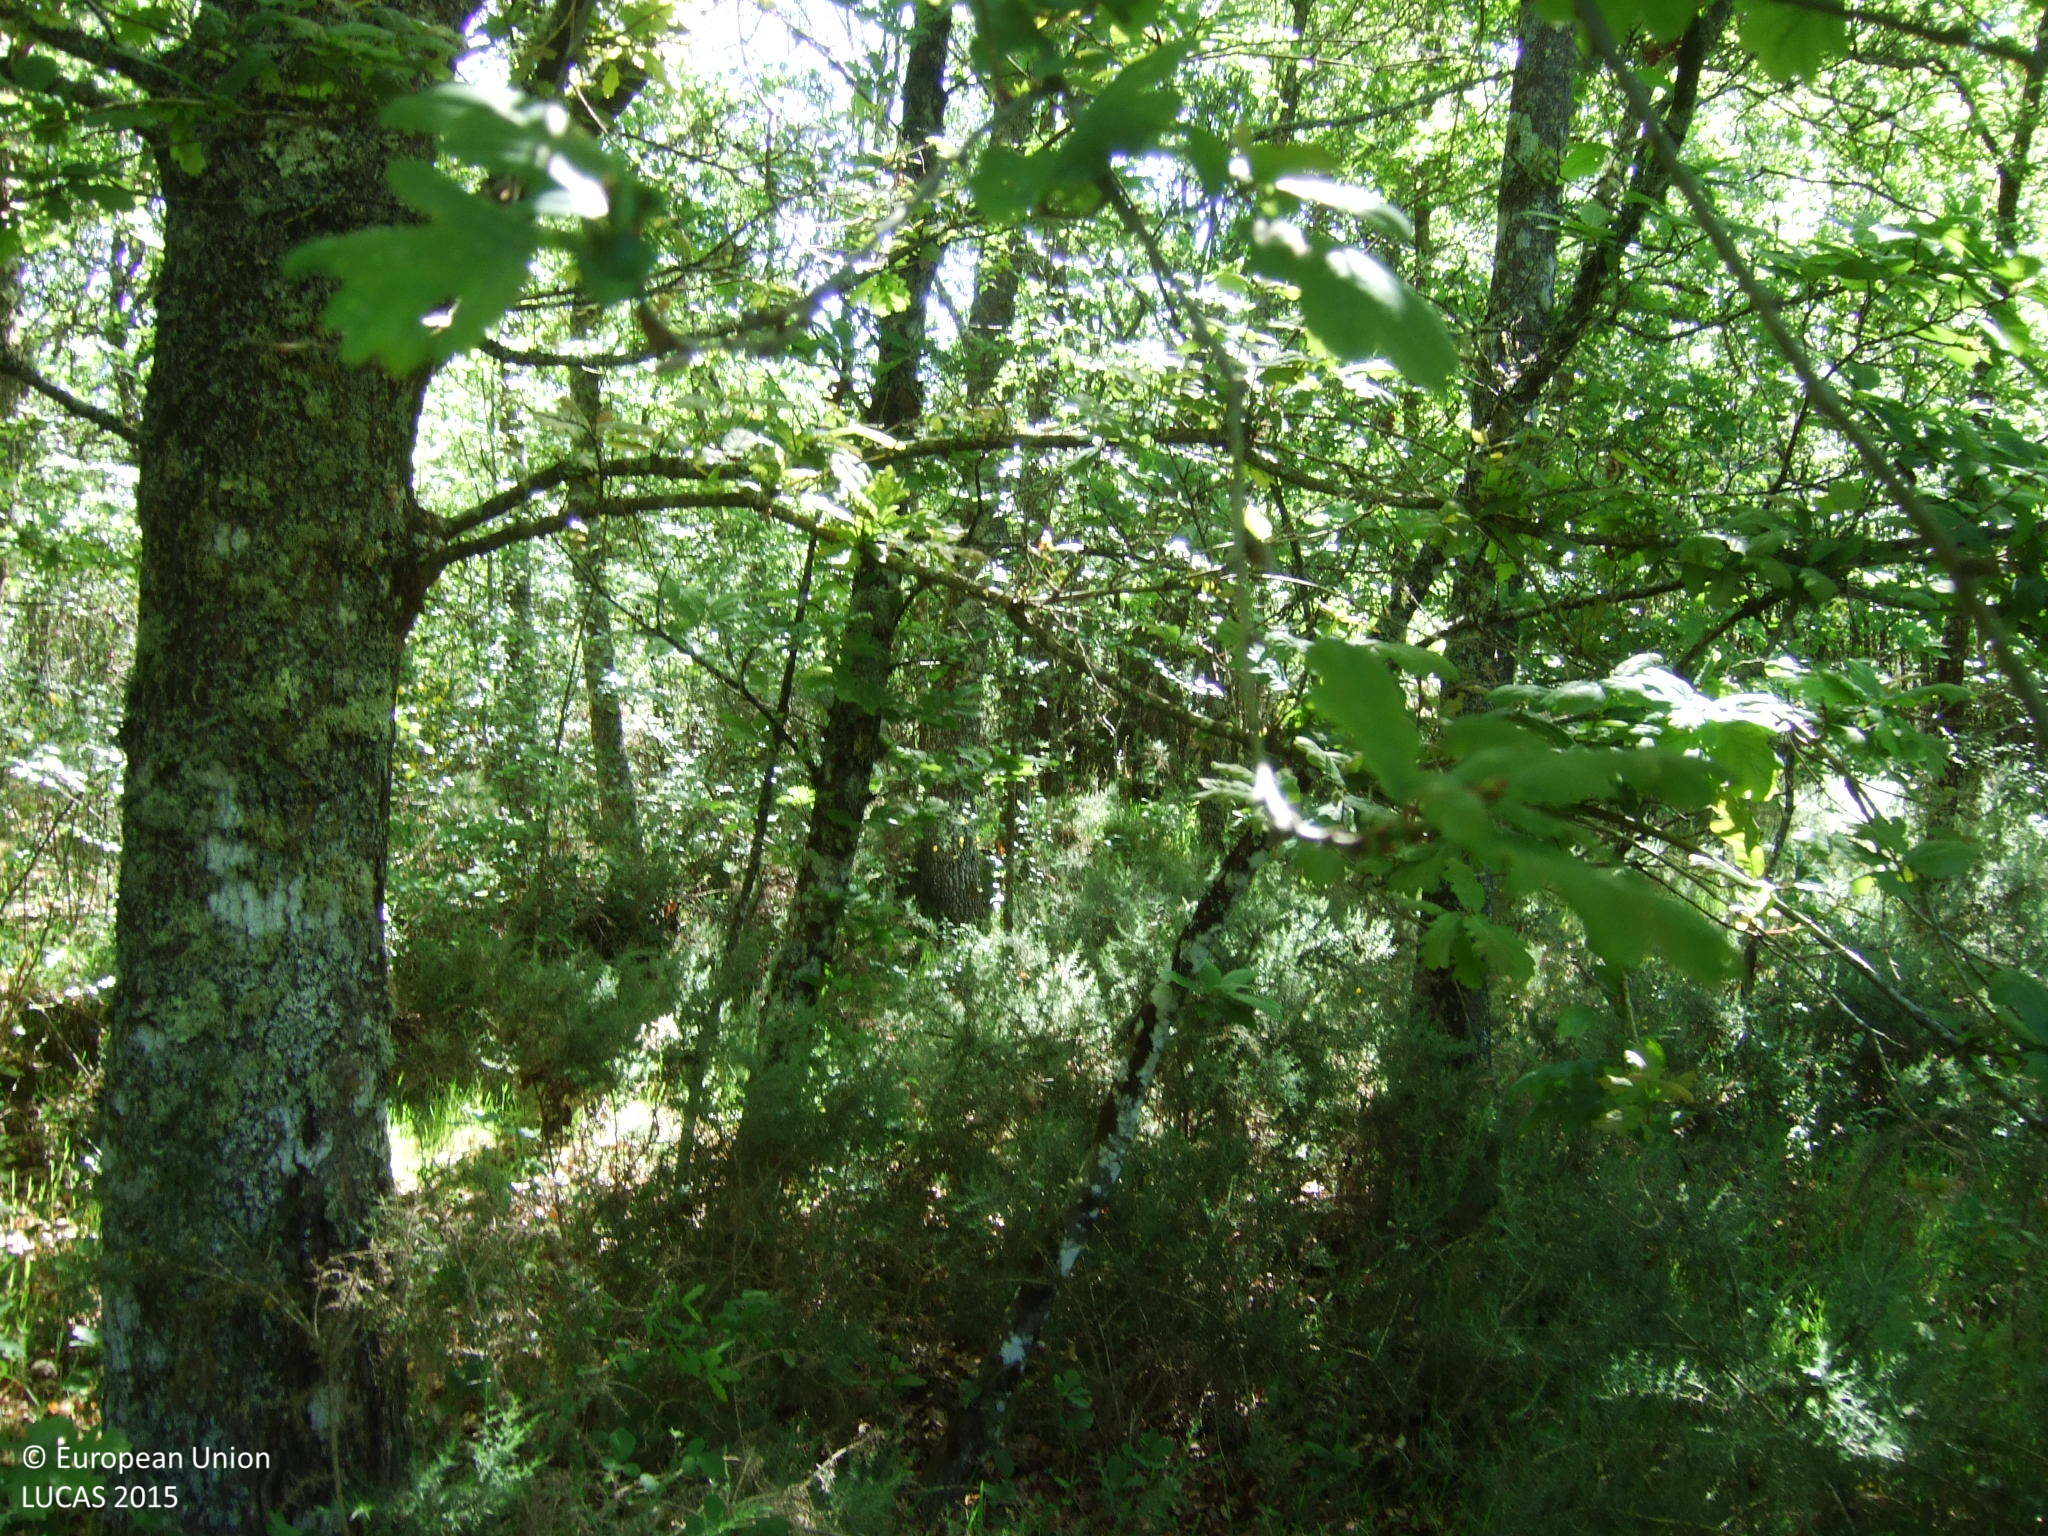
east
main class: Woodland
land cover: Broadleaved woodland
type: acidophilous oak and oak-birch forest
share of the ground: 50 - 75 %
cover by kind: broadleaved forest trees 60 %, shrubs 40 %
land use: Forestry
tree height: > 5 m
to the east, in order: Broadleaved woodland; Shrubland with sparse tree cover; Broadleaved woodland; Dry stone walls; Broadleaved woodland; Electric lines; Paved roads, cycling and walking lanes; Pine dominated coniferous woodland; Electric lines; Paved roads, cycling and walking lanes; Dry stone walls; Grassland without tree/shrub cover; Pine dominated coniferous woodland; Dry stone walls; Pine dominated coniferous woodland
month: May
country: ES
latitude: 43.1363
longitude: -7.6494
